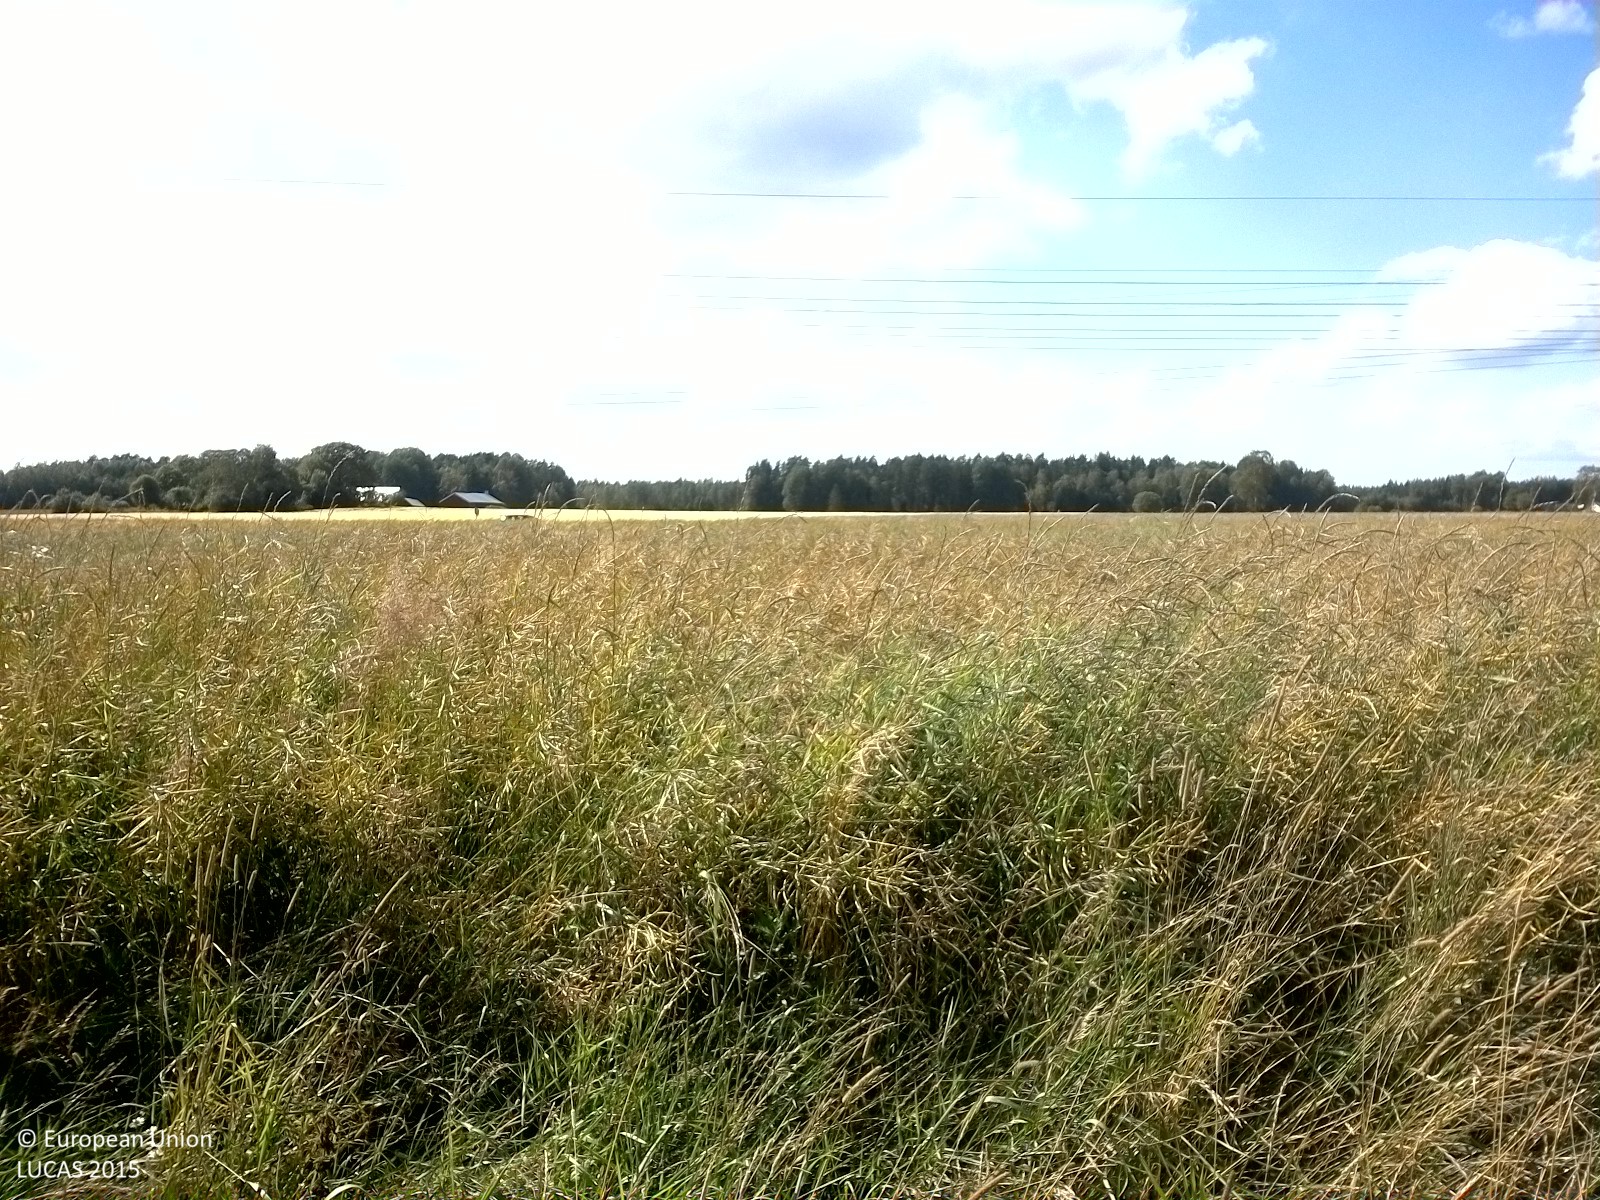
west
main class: Cropland
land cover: Rape and turnip rape
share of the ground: > 75 %
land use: Agriculture (excluding fallow land and kitchen gardens)
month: August
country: SE
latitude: 59.2230
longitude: 15.0903
